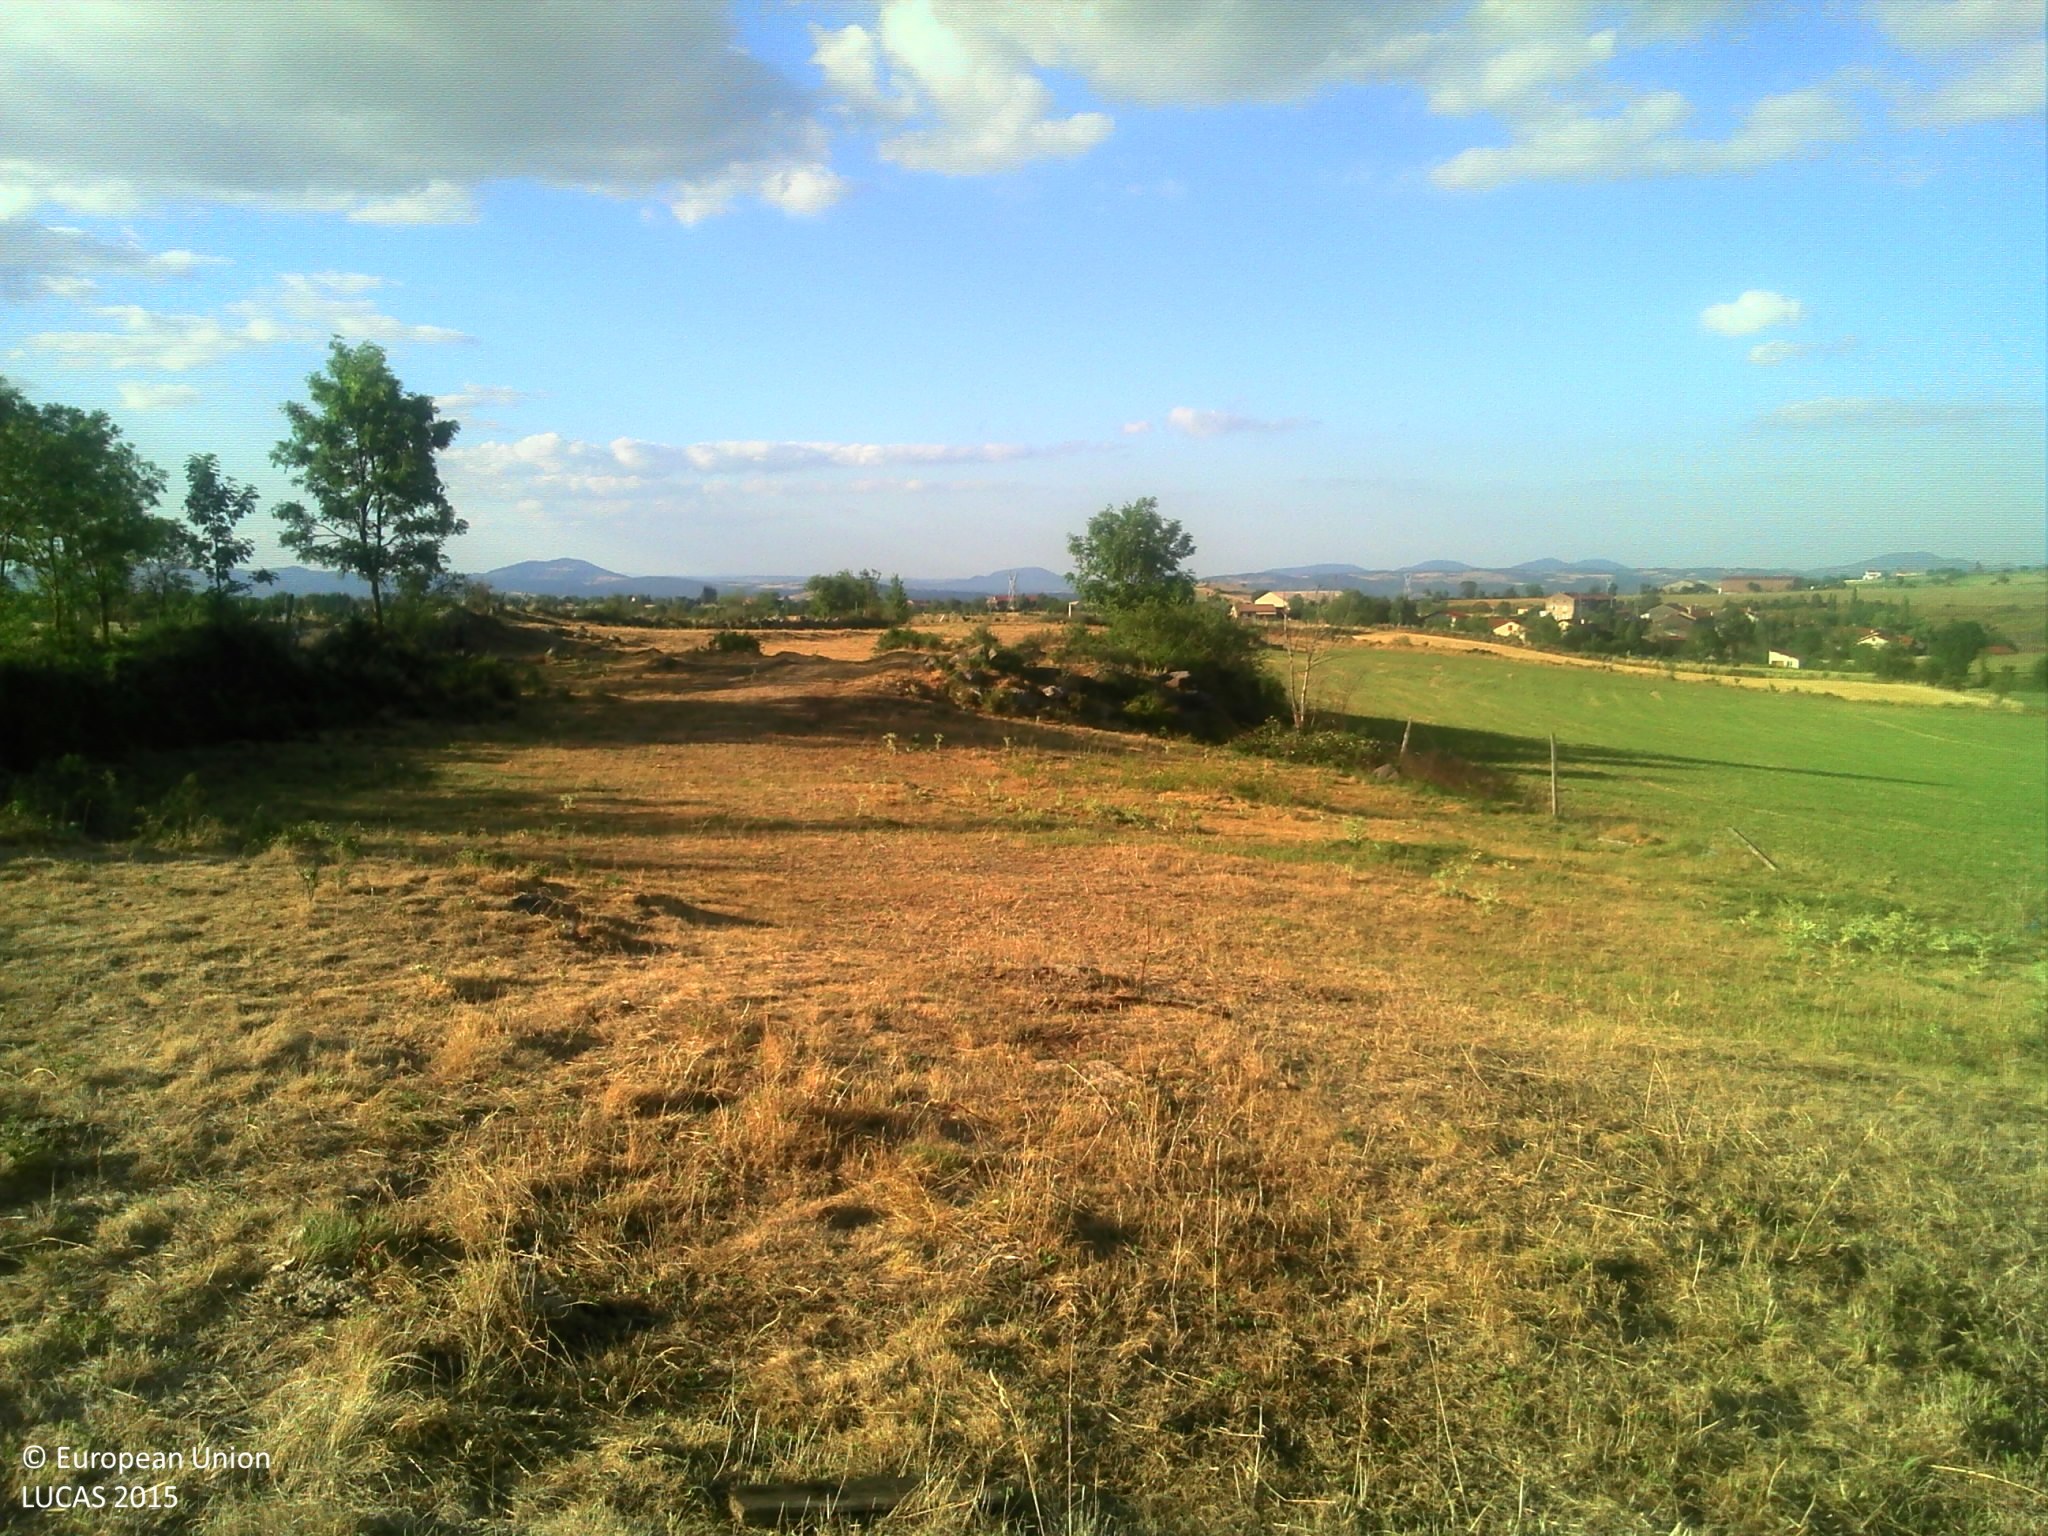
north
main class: Grassland
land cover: Grassland without tree/shrub cover
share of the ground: > 75 %
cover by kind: herbaceous plants 100 %
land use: Agriculture (excluding fallow land and kitchen gardens)
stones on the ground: < 10 %
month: July
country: FR
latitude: 44.9984
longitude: 3.8263
